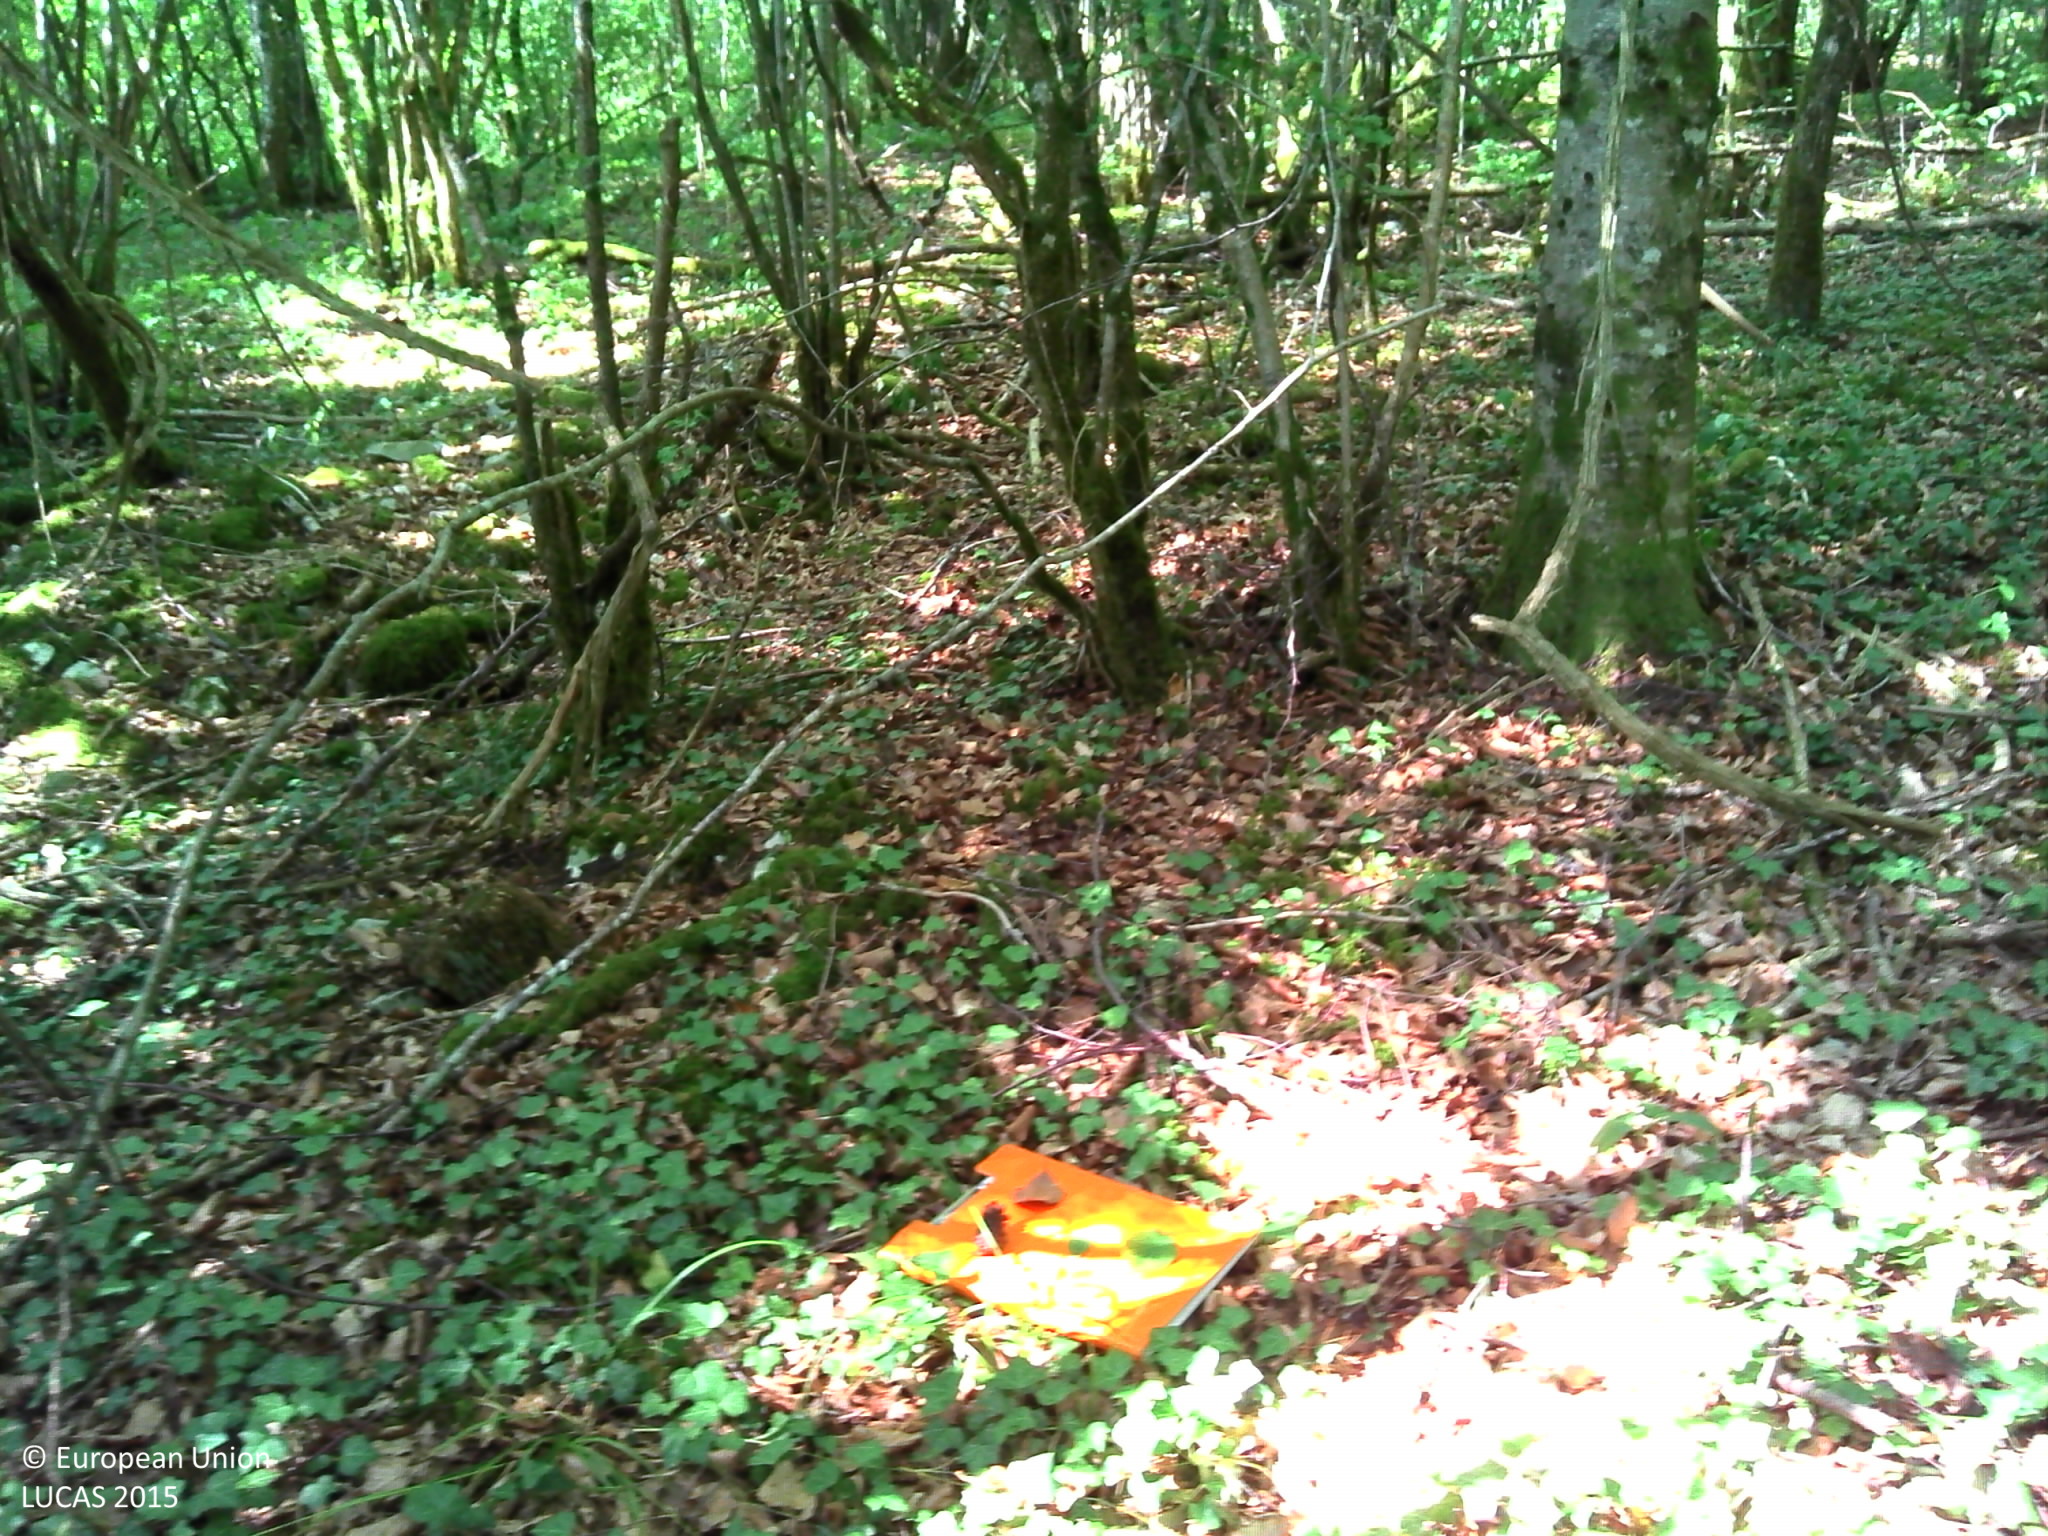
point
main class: Woodland
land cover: Broadleaved woodland
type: mesophytic deciduous forest
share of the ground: > 75 %
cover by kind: broadleaved forest trees 75 %, coniferous forest trees 10 %, lichens and mosses 10 %, herbaceous plants 5 %
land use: Forestry
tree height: > 5 m
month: July
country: FR
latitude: 48.1573
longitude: 4.8498
